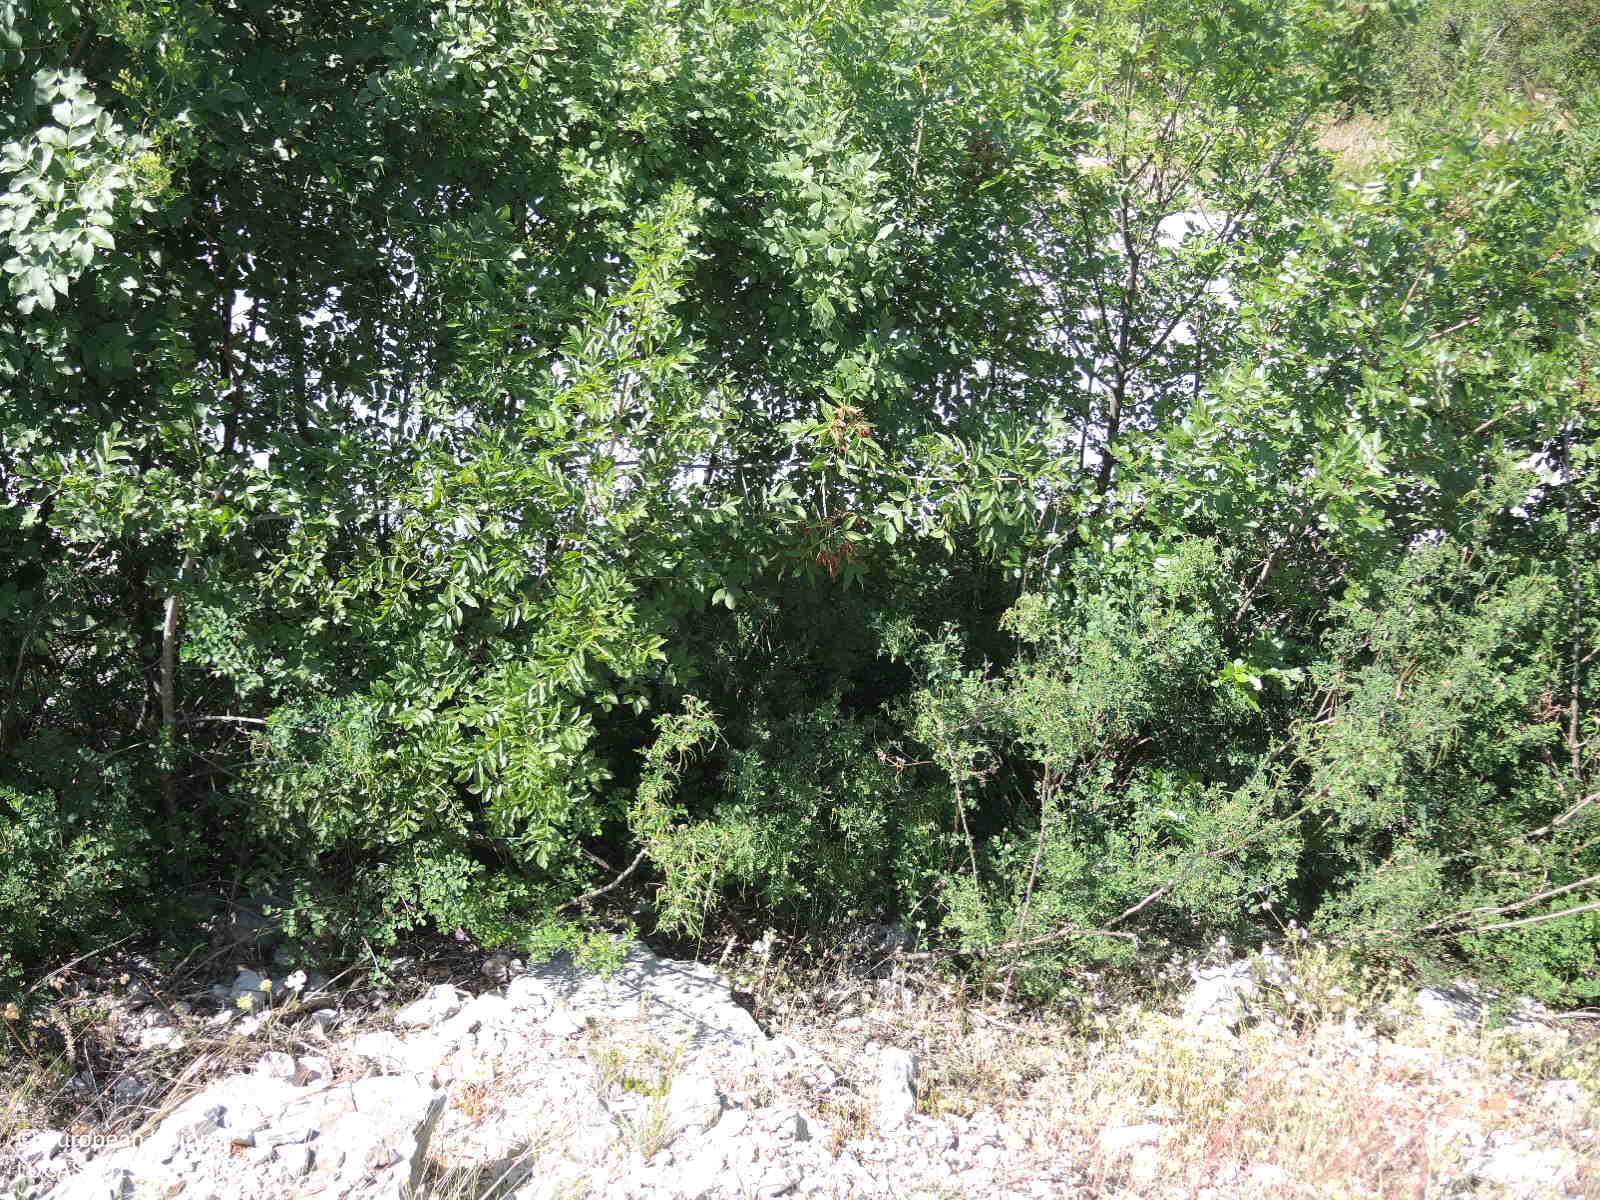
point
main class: Shrubland
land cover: Shrubland with sparse tree cover
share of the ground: 25 - 50 %
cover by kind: shrubs 45 %, herbaceous plants 20 %, unconsolidated bare surface 20 %, consolidated bare surface 10 %, broadleaved forest trees 5 %
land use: Semi-natural and natural areas not in use
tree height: < 5 m
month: June
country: HR
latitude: 43.6210
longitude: 16.2243
